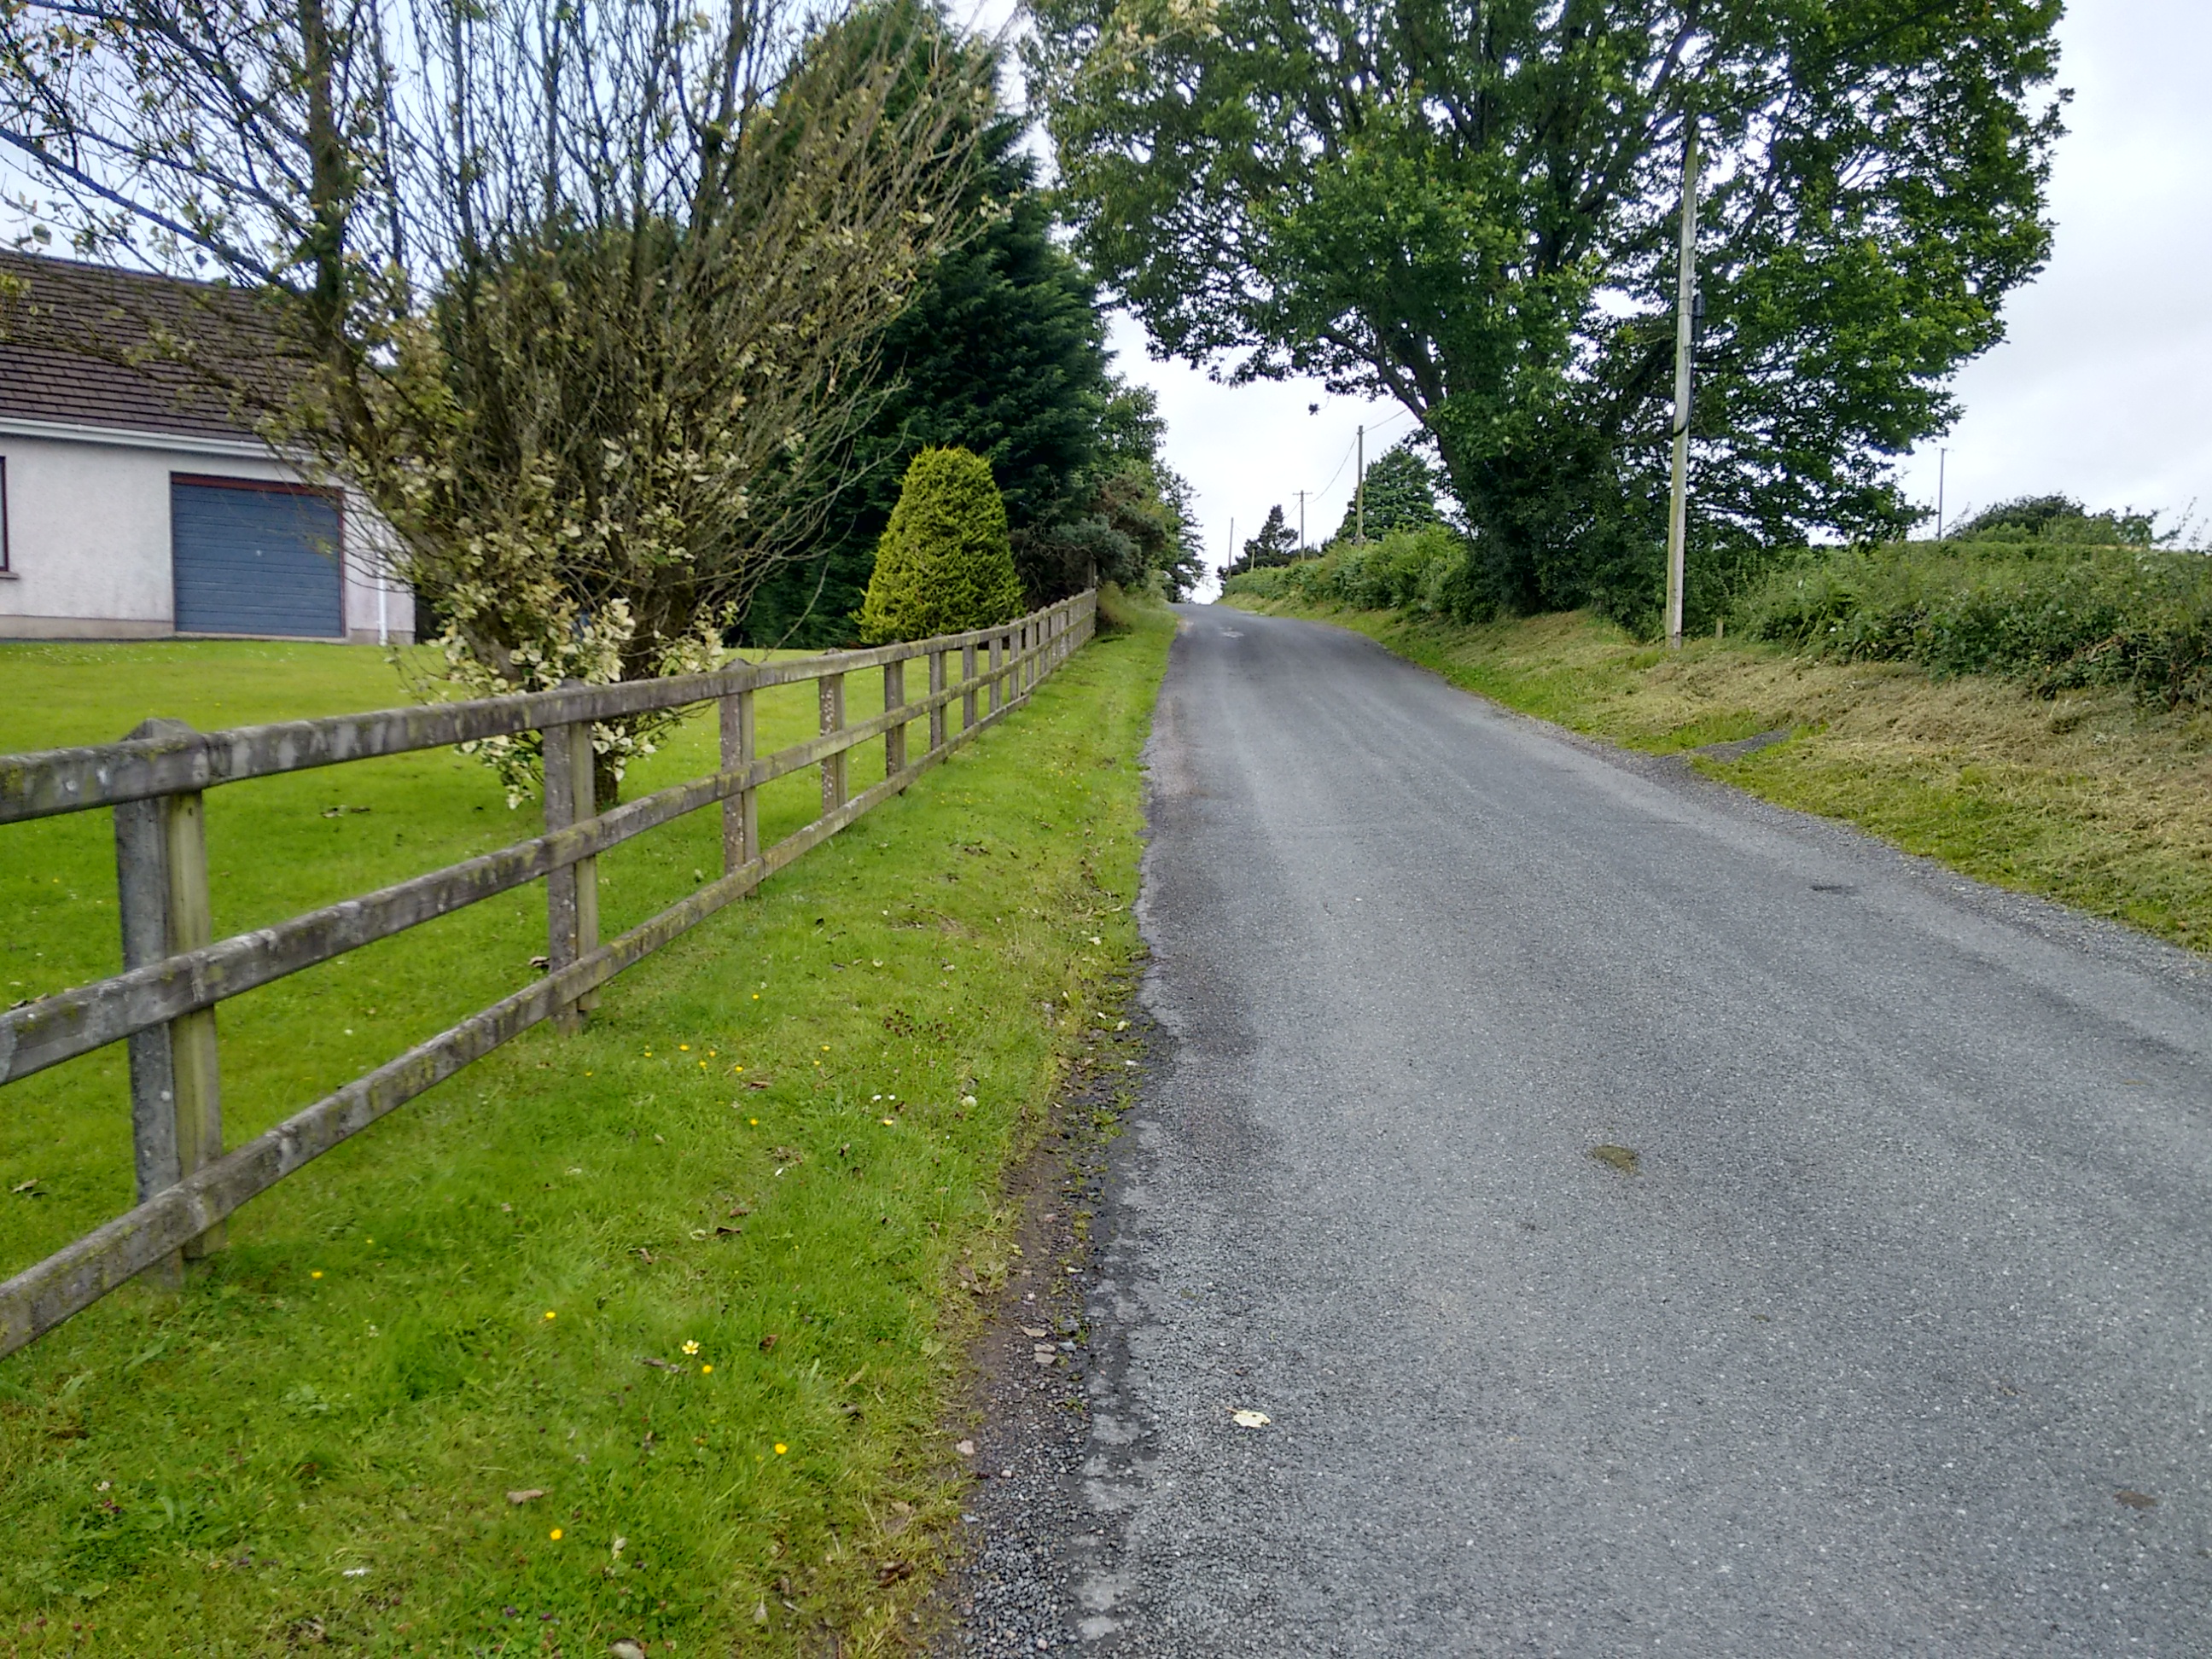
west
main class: Grassland
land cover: Grassland with sparse tree/shrub cover
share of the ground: > 75 %
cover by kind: herbaceous plants 85 %, shrubs 10 %, broadleaved forest trees 5 %
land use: Agriculture (excluding fallow land and kitchen gardens)
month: August
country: GB
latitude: 54.6330
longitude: -6.8821
